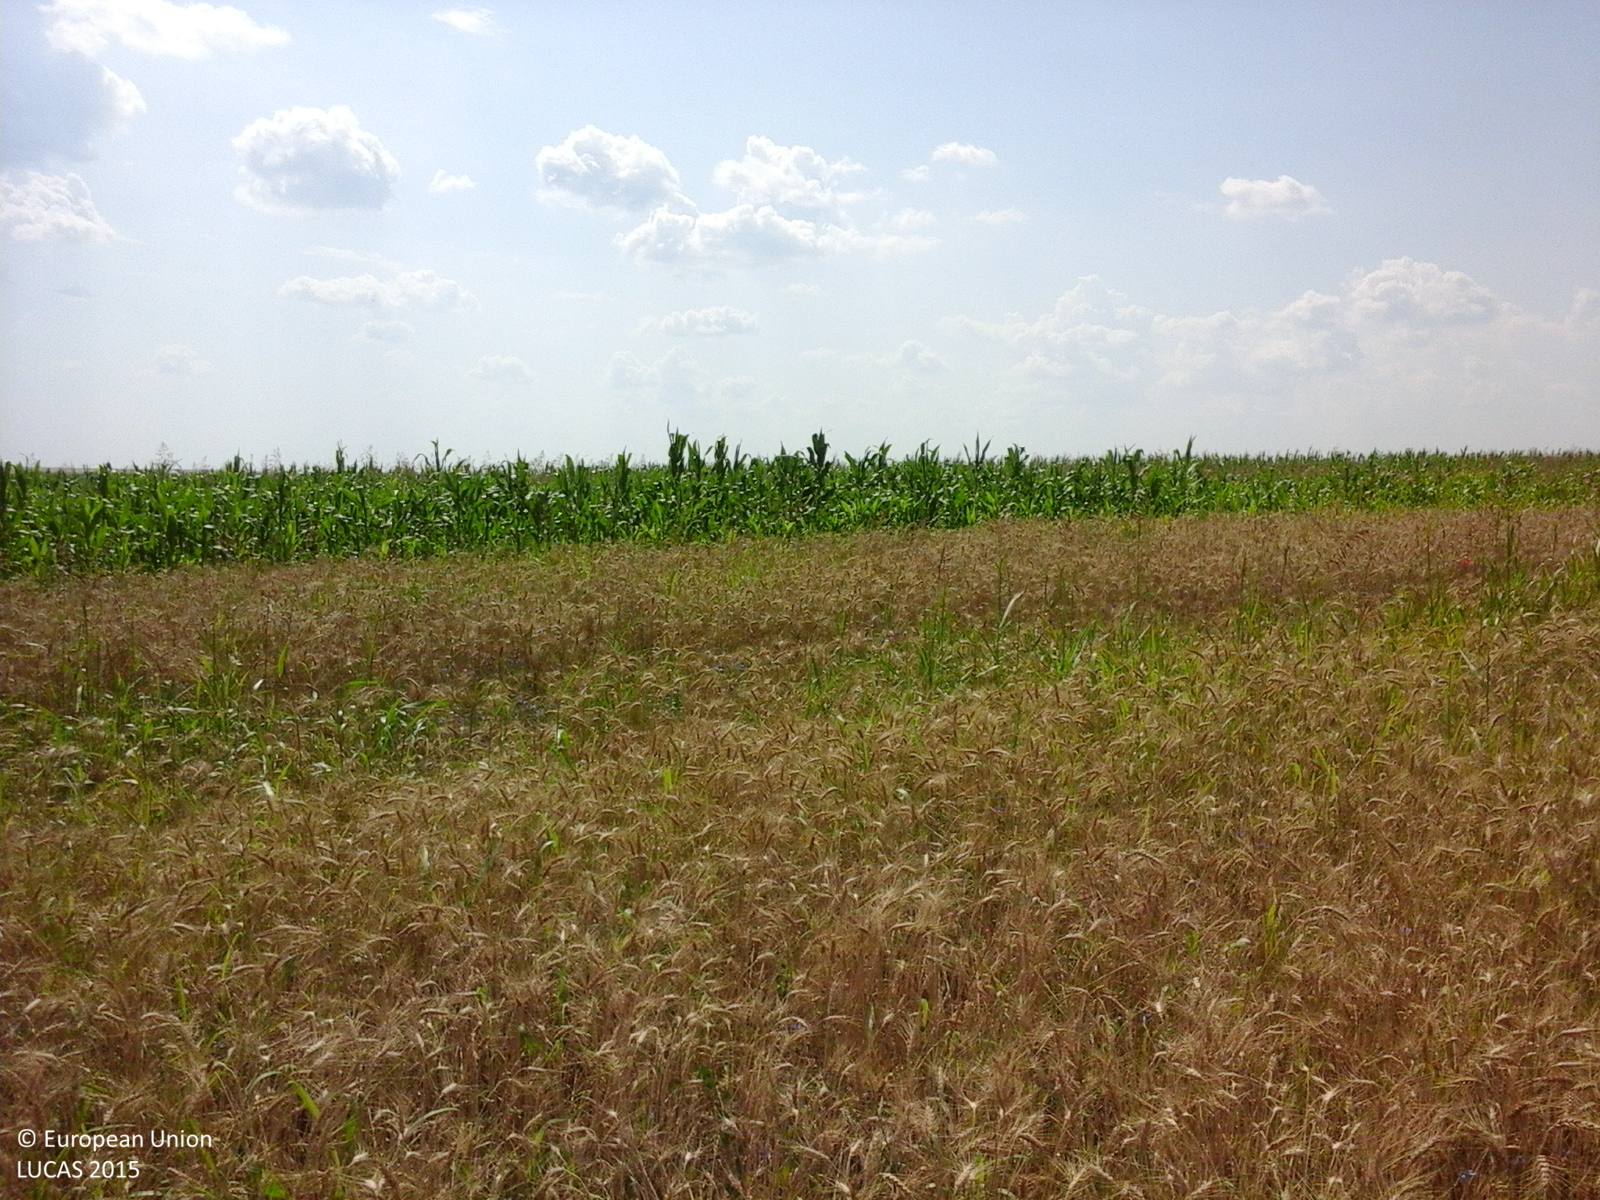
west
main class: Cropland
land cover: Common wheat
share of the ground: > 75 %
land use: Agriculture (excluding fallow land and kitchen gardens)
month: July
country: RO
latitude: 44.0199
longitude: 25.2641
